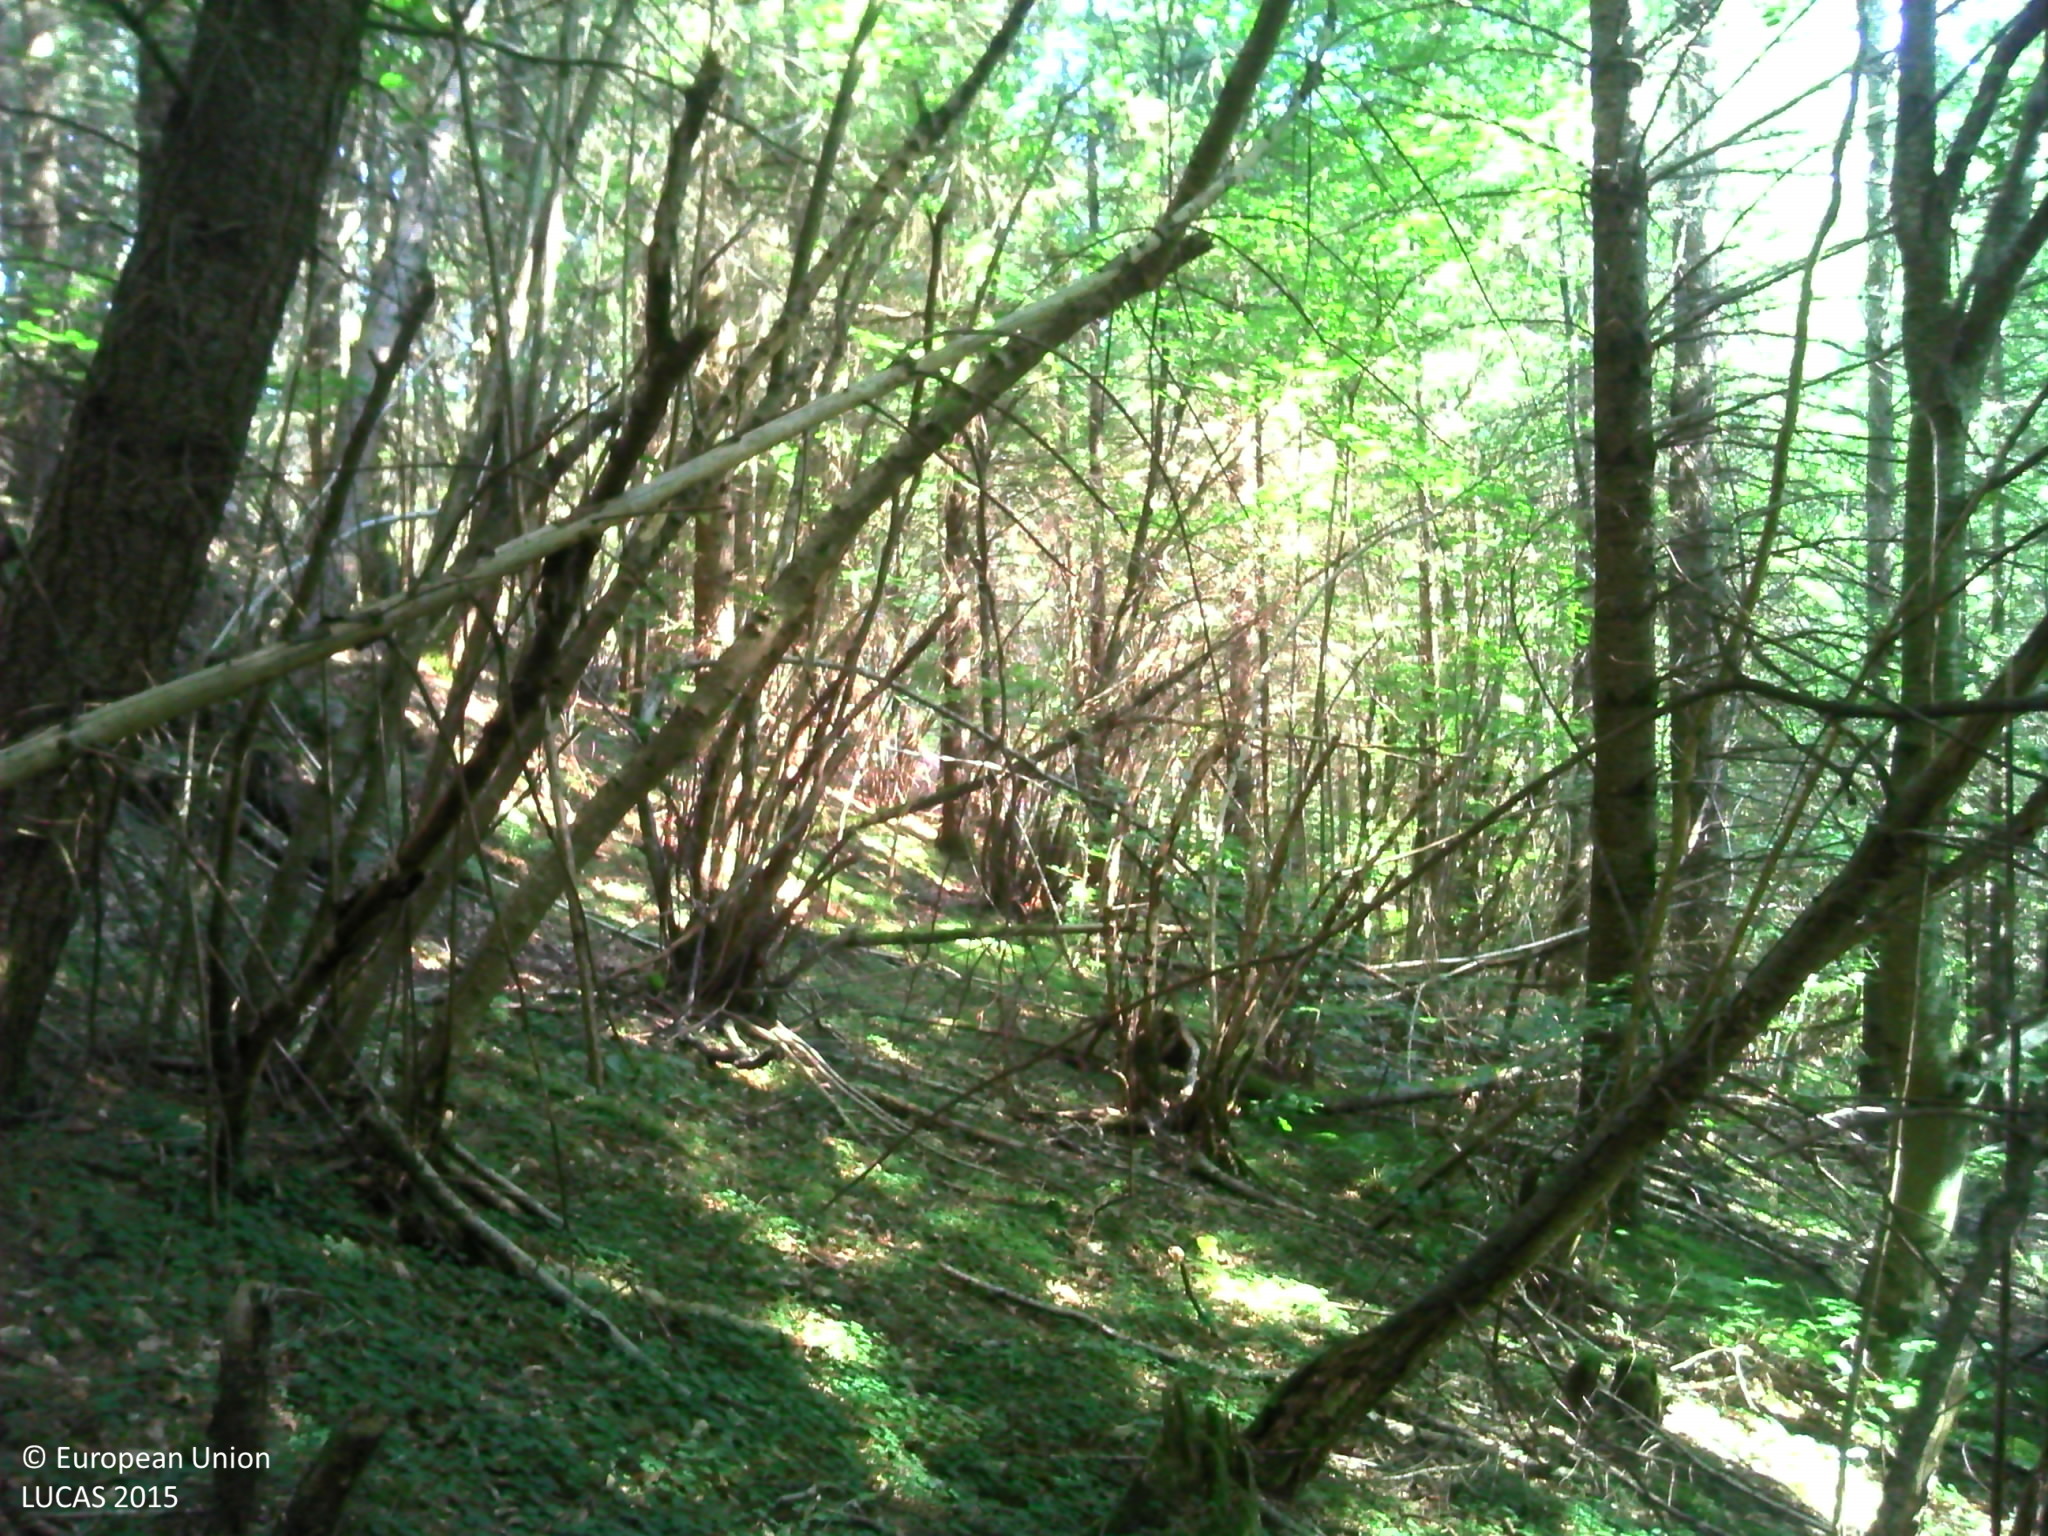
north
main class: Woodland
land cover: Pine dominated mixed woodland
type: beech forest
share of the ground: > 75 %
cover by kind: coniferous forest trees 60 %, broadleaved forest trees 20 %, shrubs 20 %
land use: Forestry
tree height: > 5 m
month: August
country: FR
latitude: 45.2527
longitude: 3.8490
